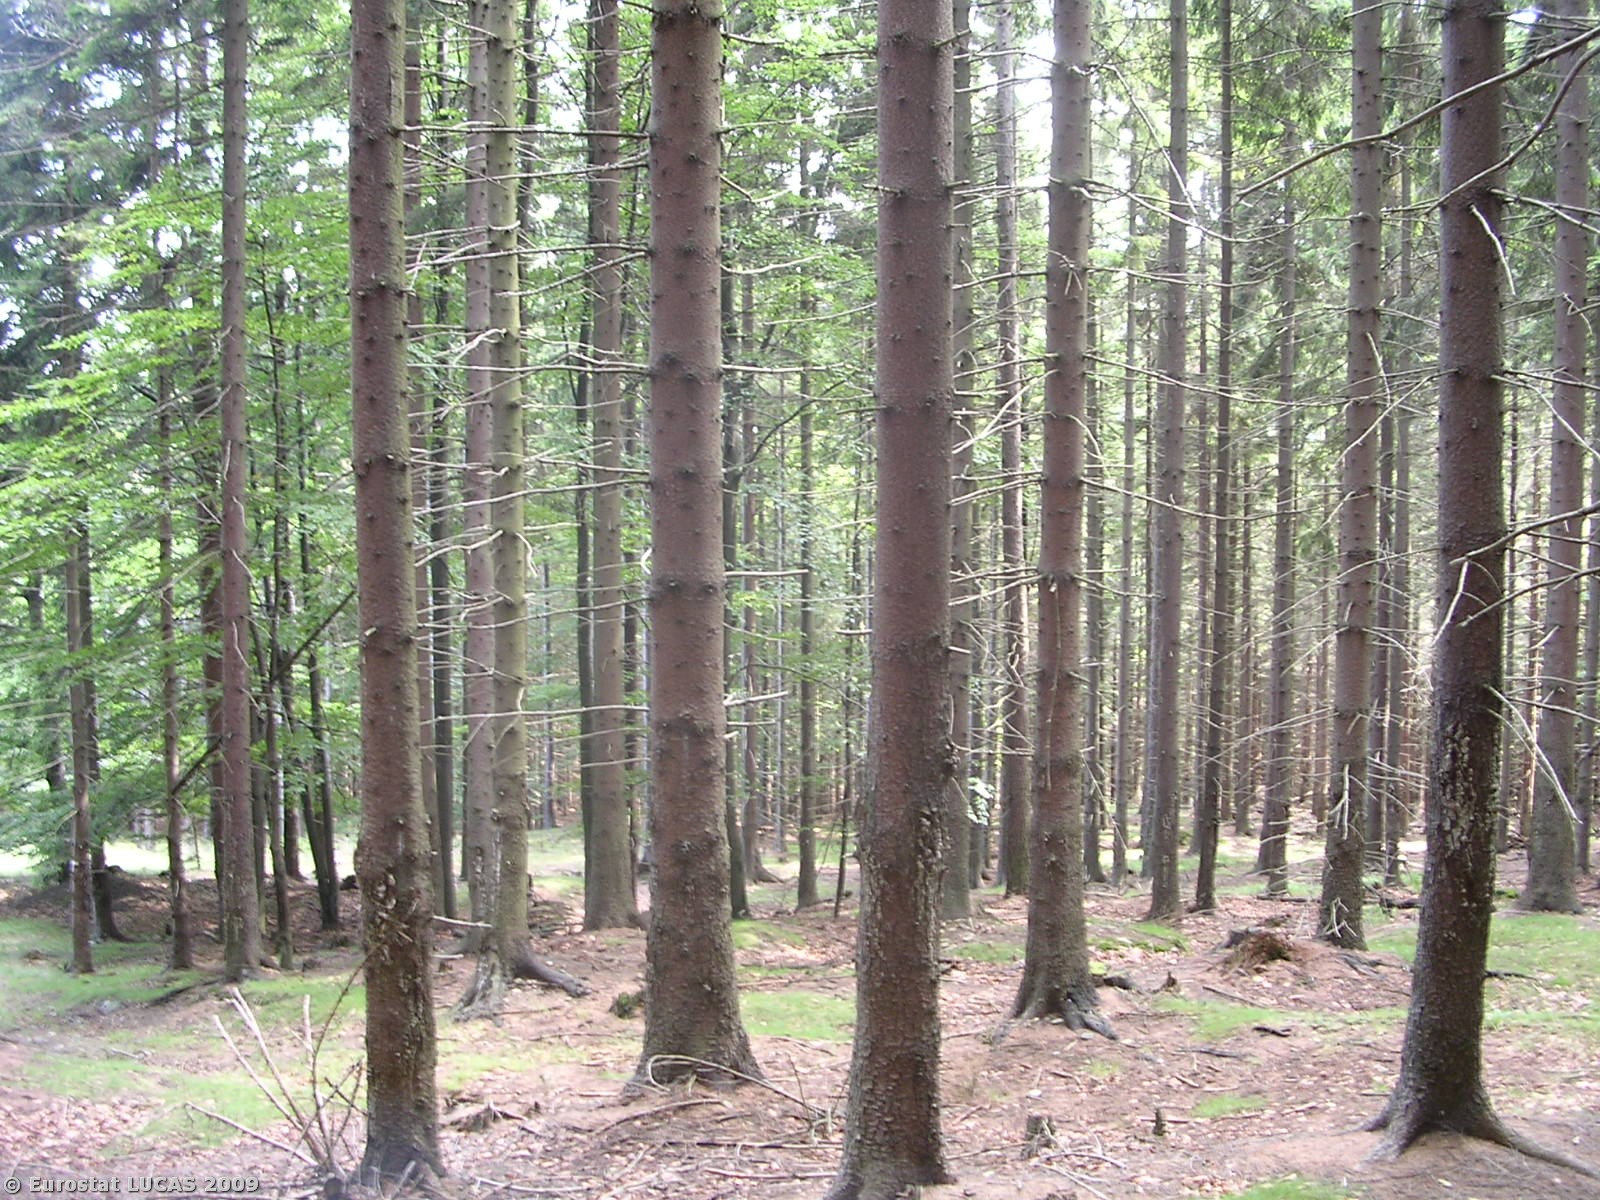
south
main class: Woodland
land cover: Mixed woodland
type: hemiboreal forest and nemoral coniferous forest and mixed broadleaved-coniferous forest
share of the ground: > 75 %
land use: Forestry
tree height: > 5 m
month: July
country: CZ
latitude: 50.8315
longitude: 14.5596
